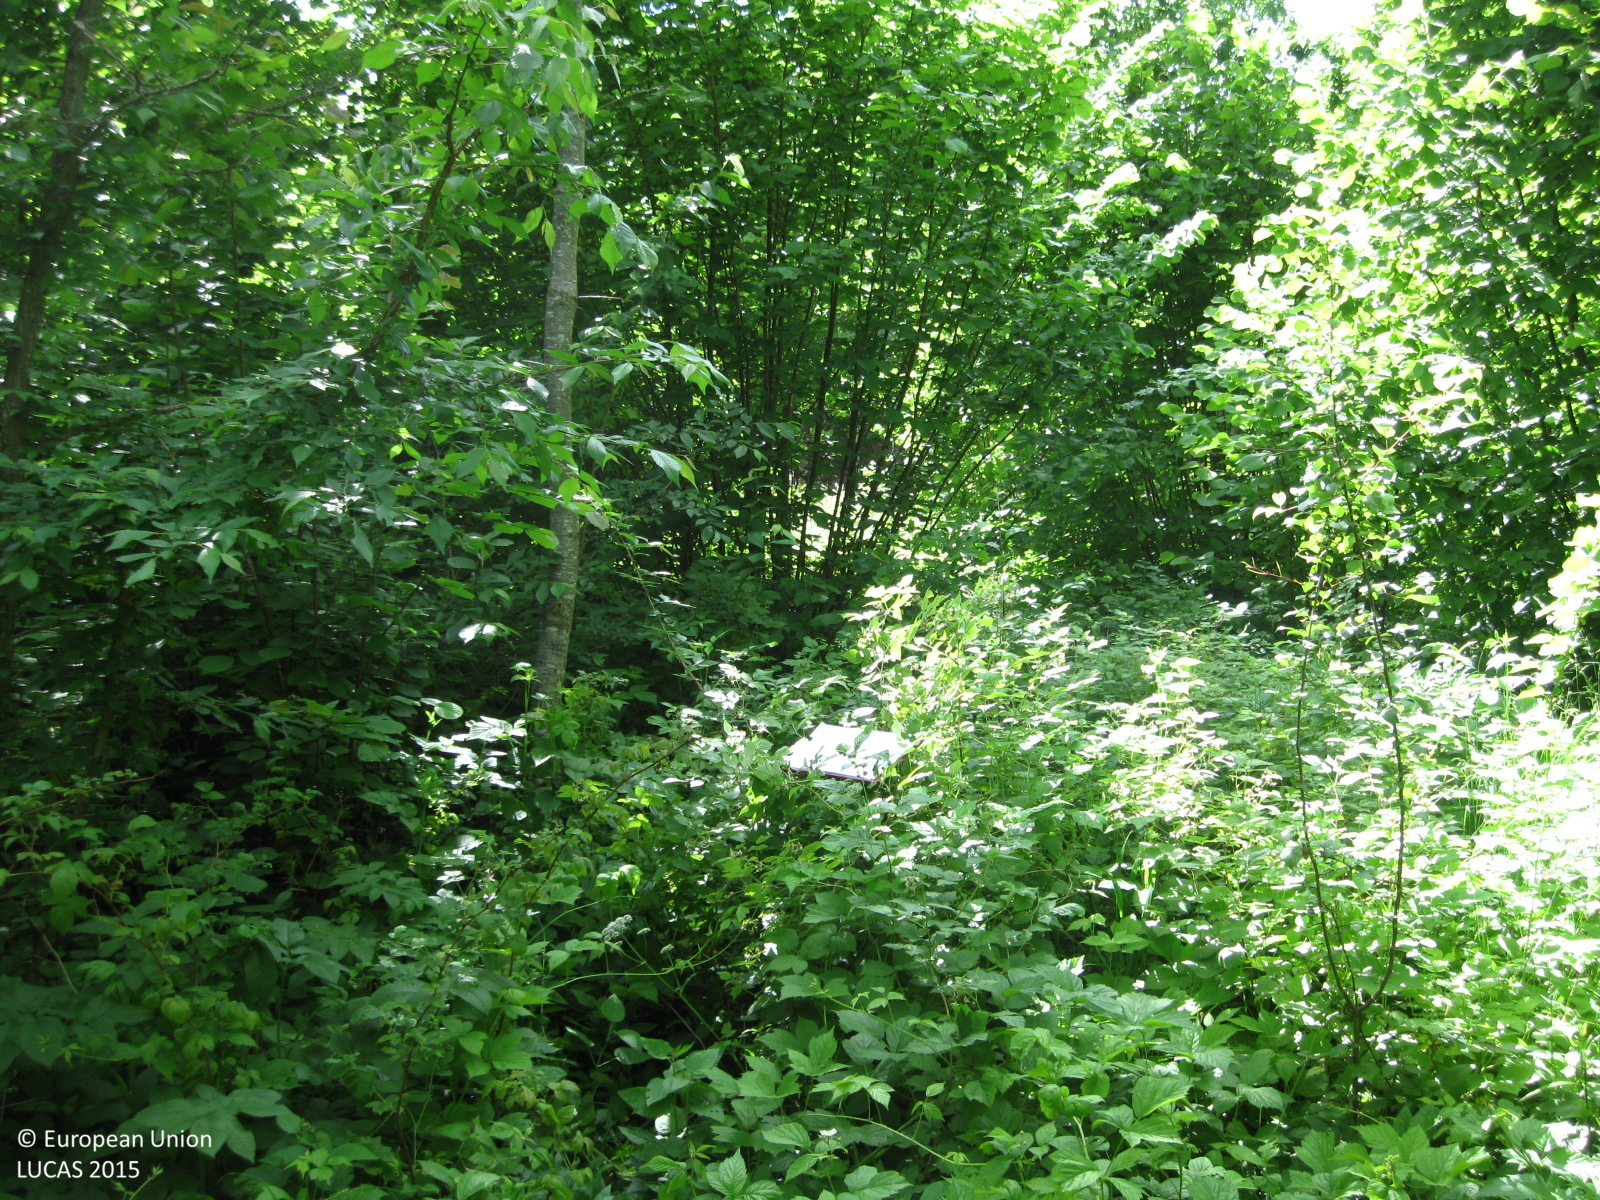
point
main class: Woodland
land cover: Broadleaved woodland
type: non-riverine alder, birch or aspen forest
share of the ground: 50 - 75 %
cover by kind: broadleaved forest trees 70 %, shrubs 15 %, herbaceous plants 15 %
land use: Forestry
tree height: > 5 m
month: June
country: LT
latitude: 55.3788
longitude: 23.8324
